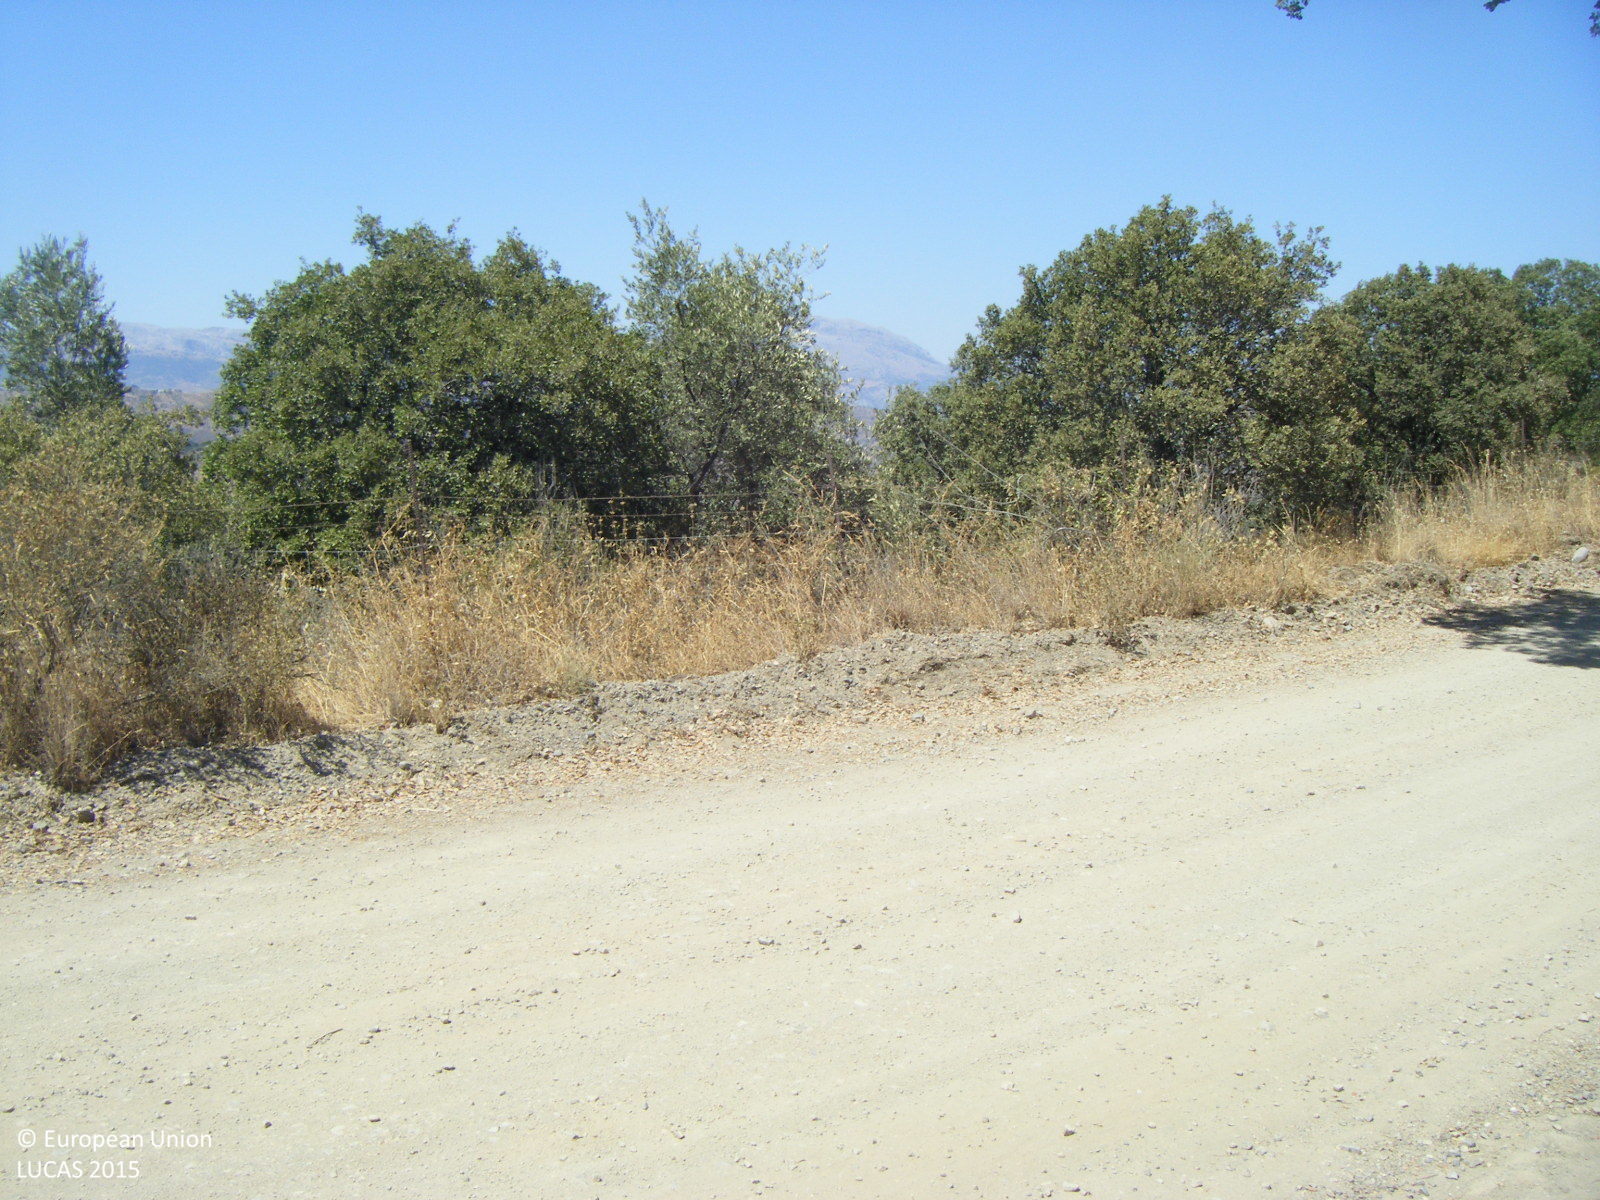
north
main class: Cropland
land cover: Nuts trees
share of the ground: 10 - 25 %
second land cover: Spontaneously vegetated surfaces
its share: > 75 %
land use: Abandoned areas
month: July
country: ES
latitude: 36.8395
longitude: -4.3330
